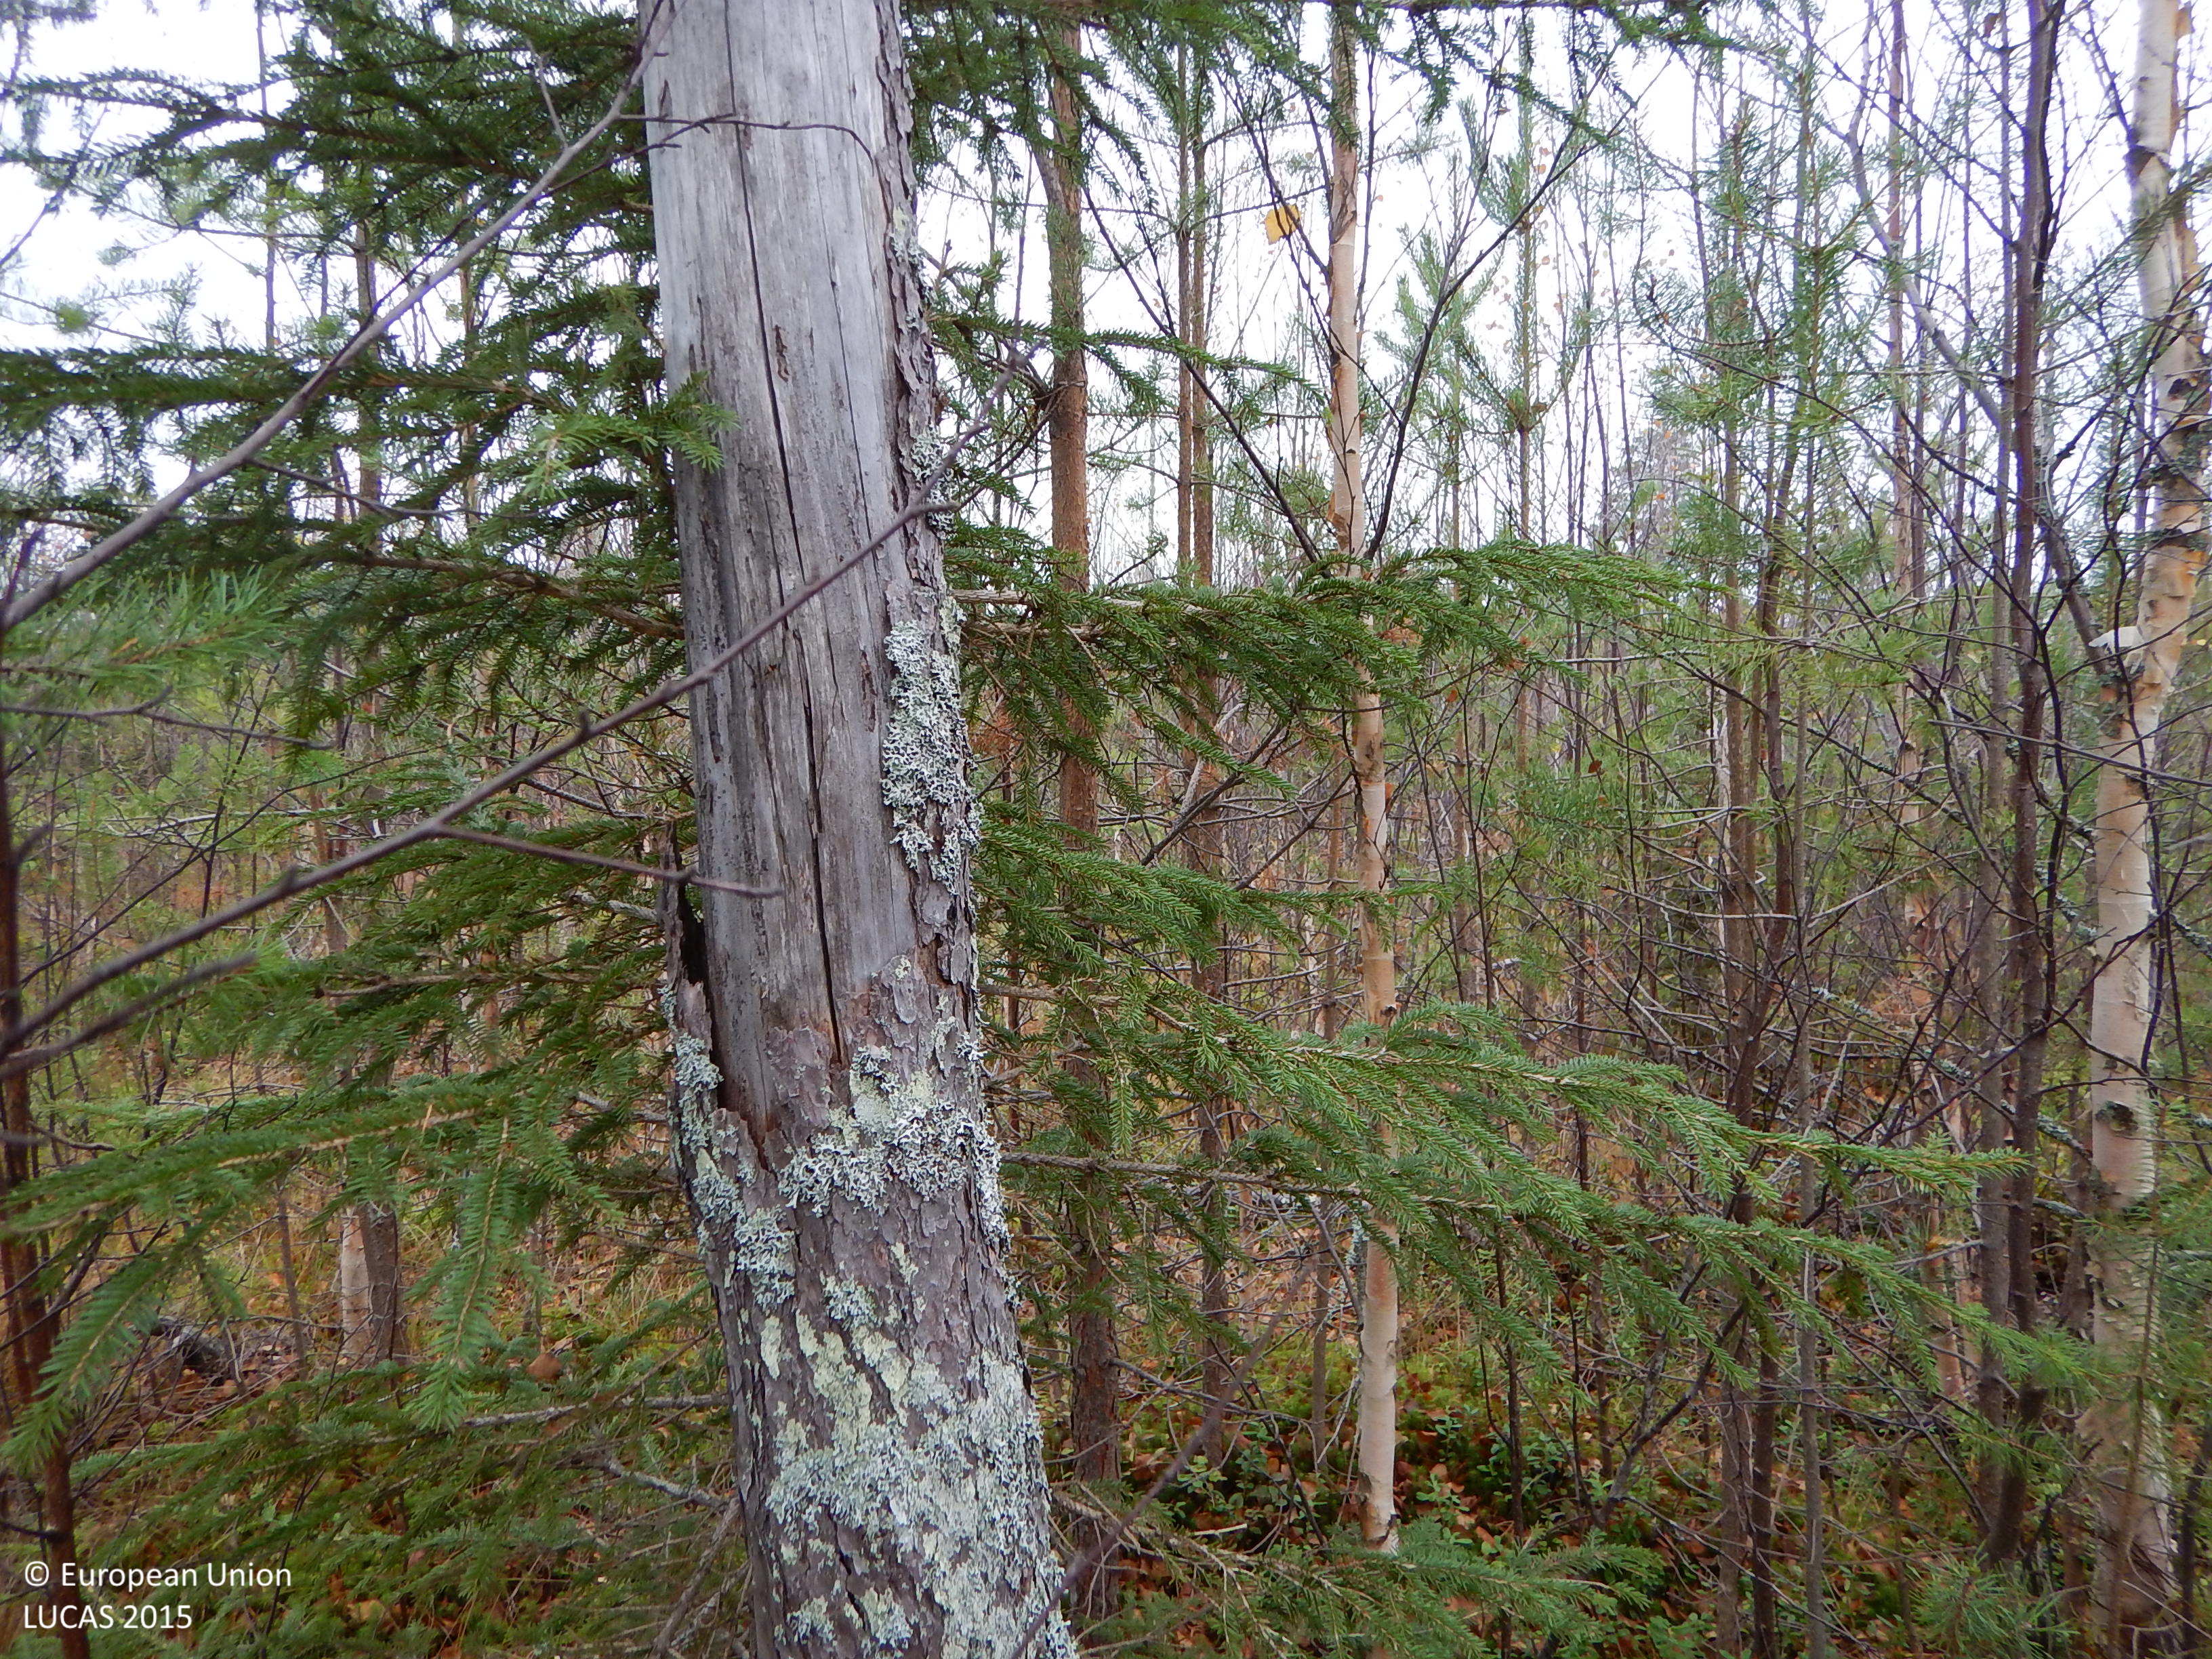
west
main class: Woodland
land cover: Other mixed woodland
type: boreal forest
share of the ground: 50 - 75 %
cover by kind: coniferous forest trees 30 %, broadleaved forest trees 20 %, shrubs 20 %, lichens and mosses 20 %, herbaceous plants 10 %
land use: Forestry
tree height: < 5 m
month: October
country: SE
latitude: 64.9558
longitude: 21.1348
